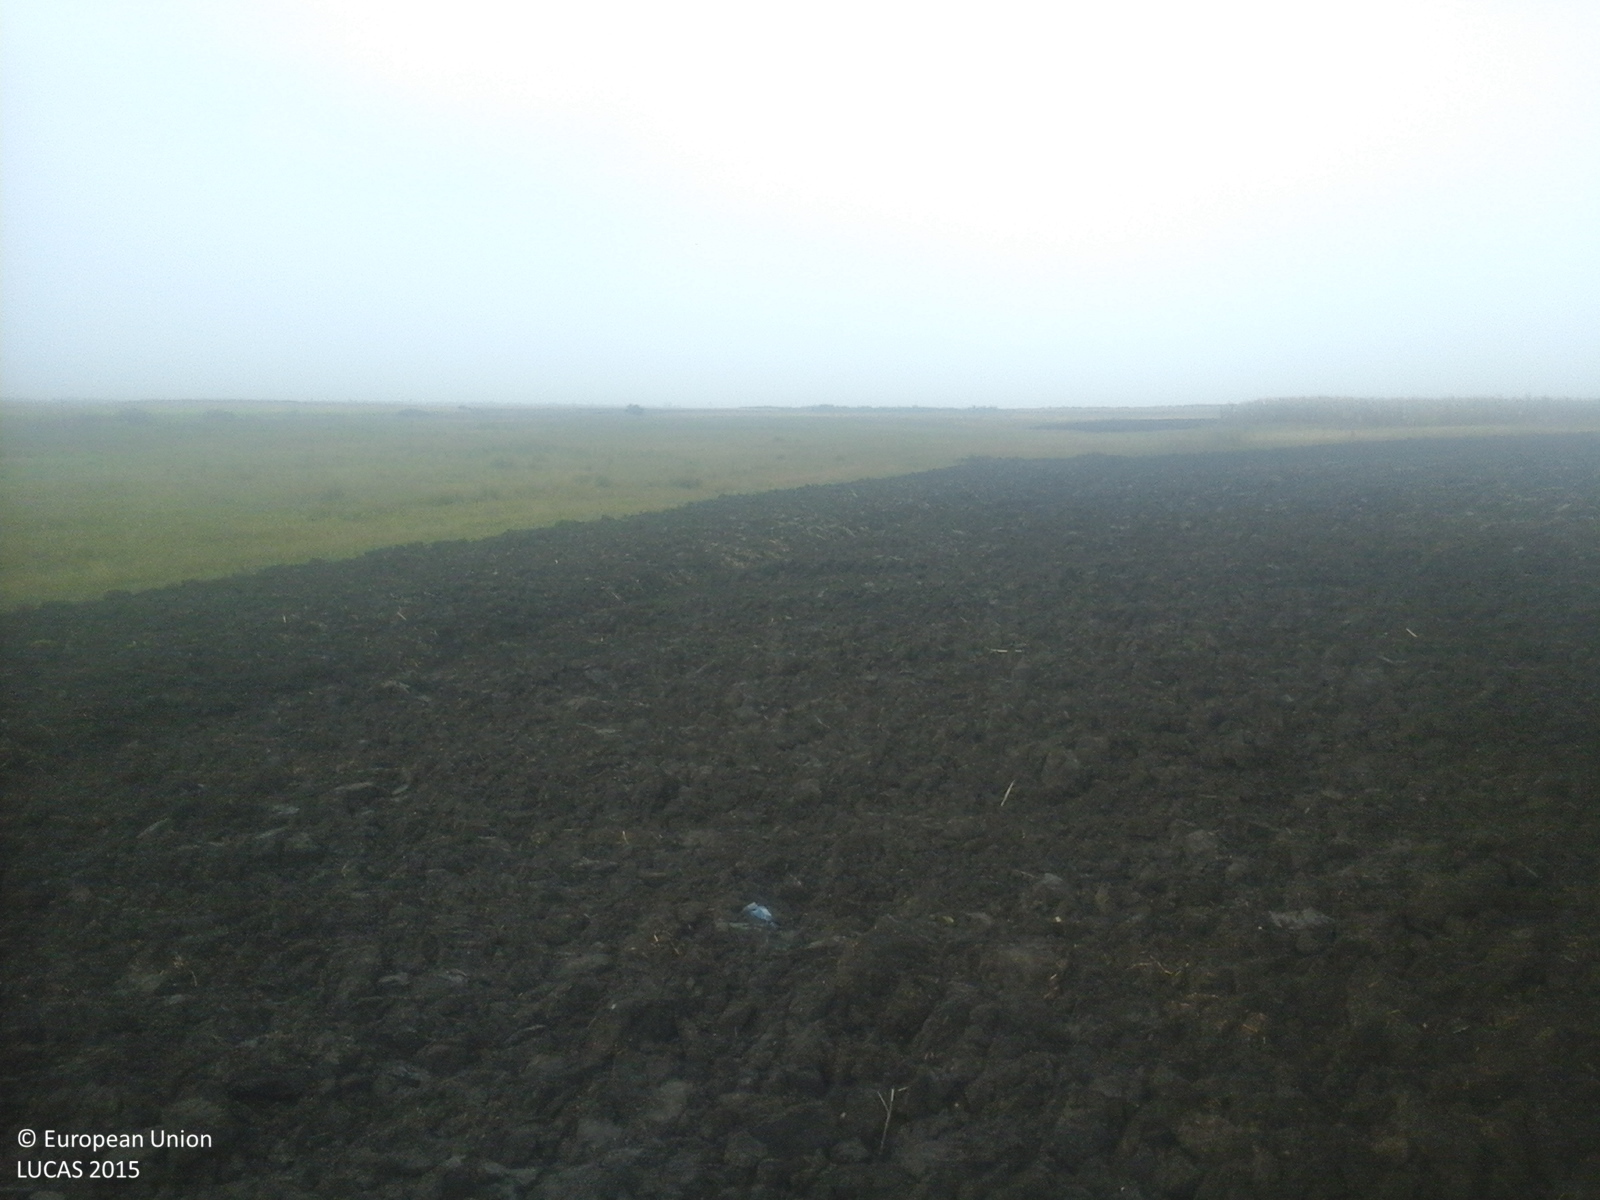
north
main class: Cropland
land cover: Rape and turnip rape
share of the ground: < 10 %
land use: Agriculture (excluding fallow land and kitchen gardens)
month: September
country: RO
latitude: 47.5358
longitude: 22.4236
